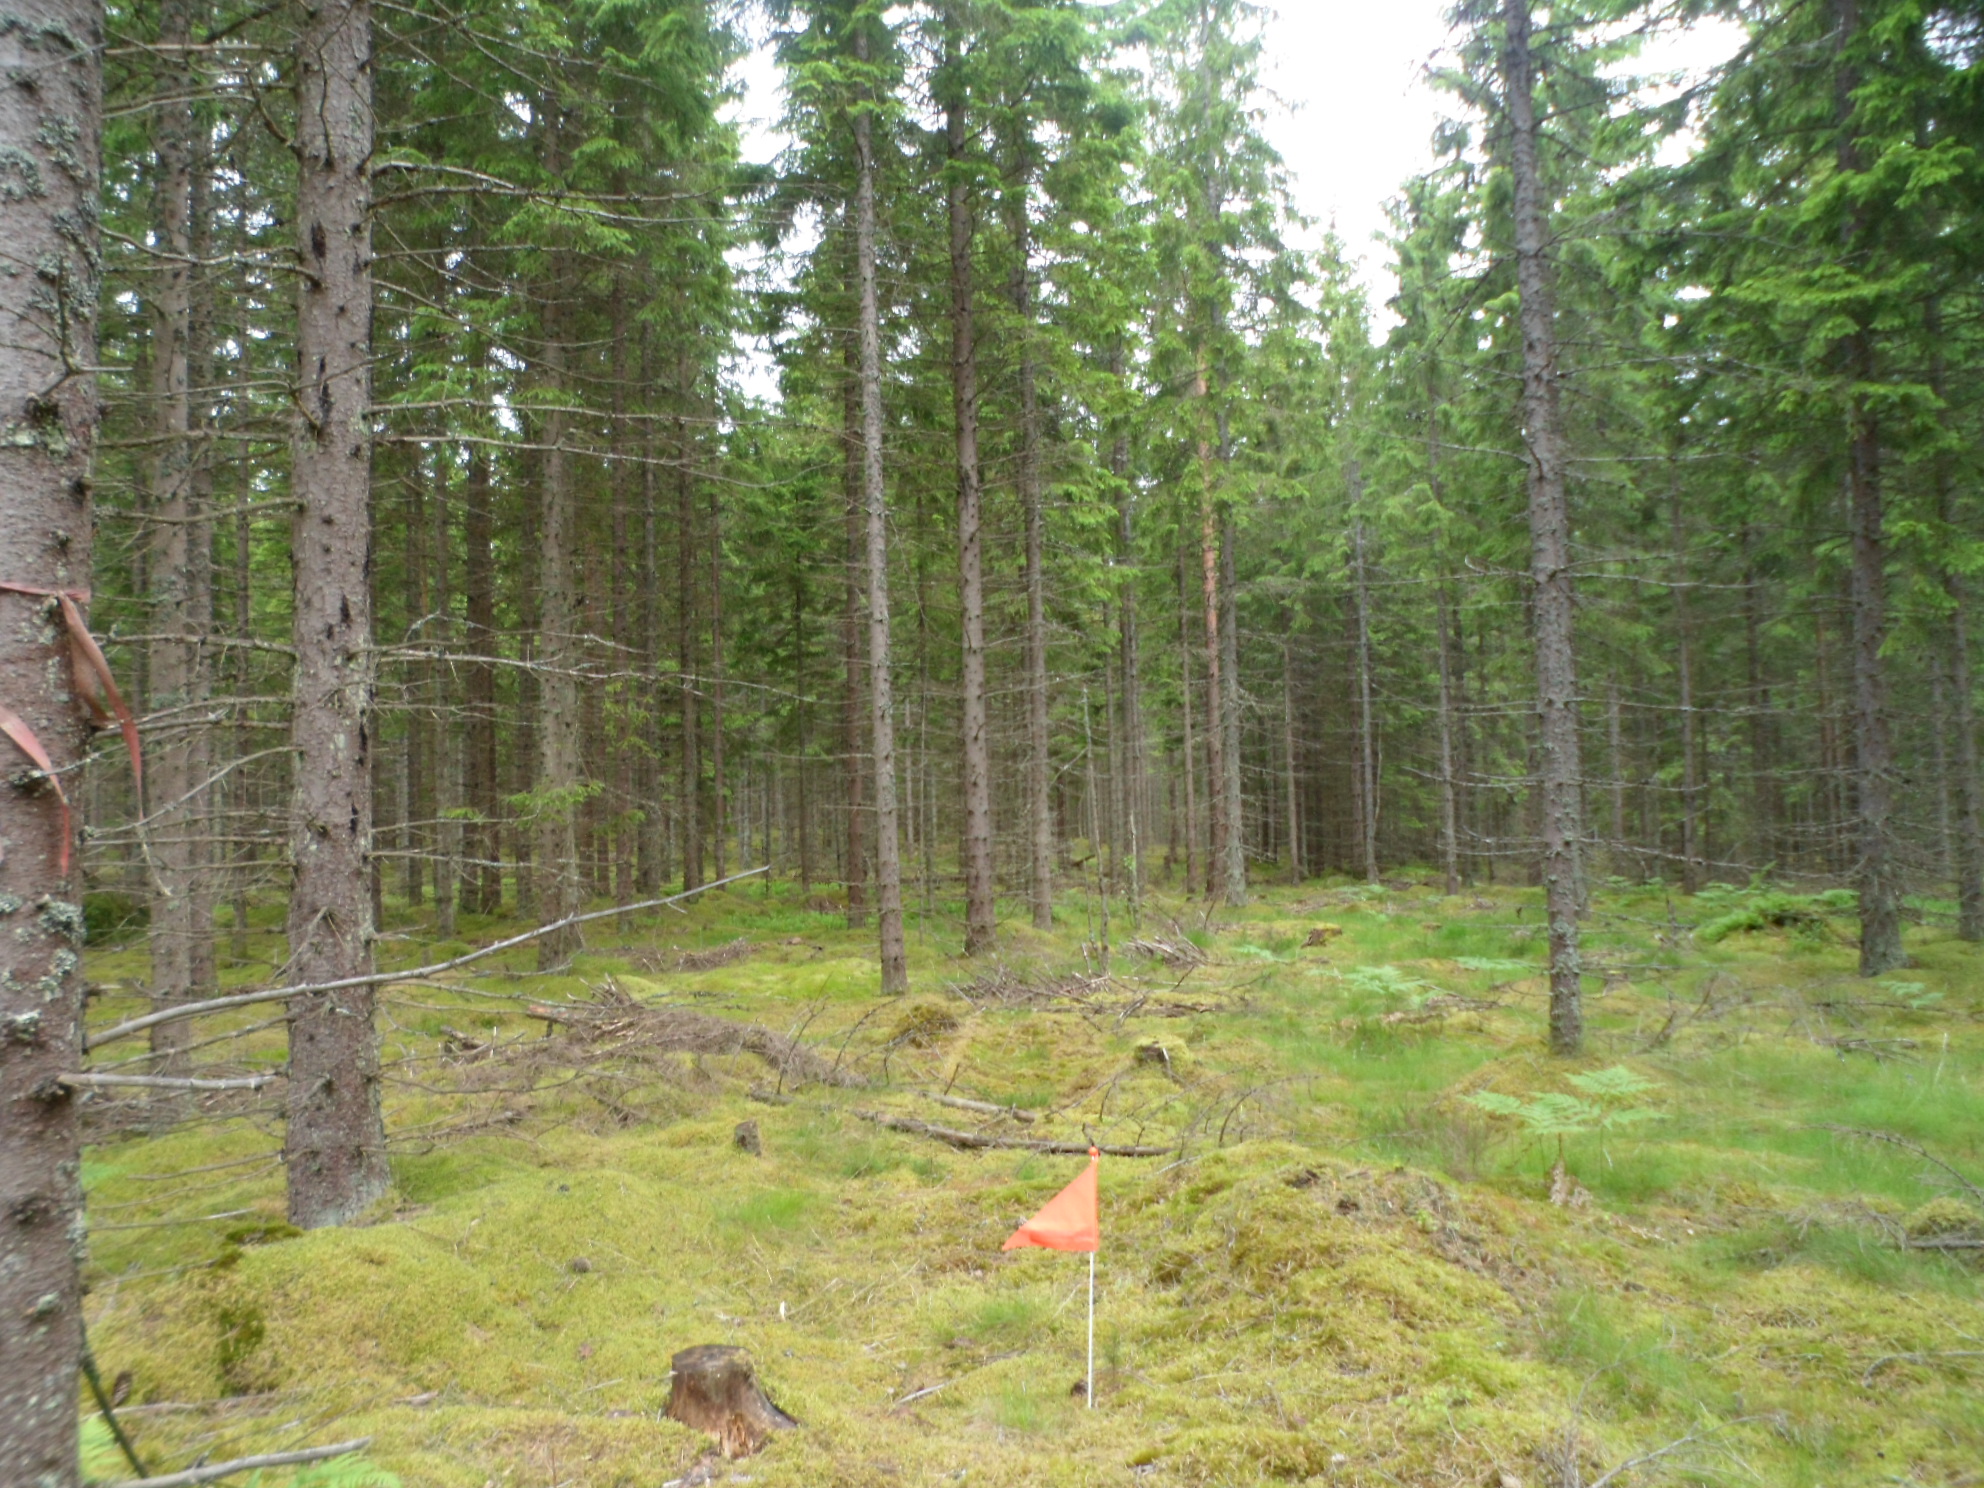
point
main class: Woodland
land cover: Spruce dominated coniferous woodland
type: boreal forest
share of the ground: 50 - 75 %
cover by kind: coniferous forest trees 55 %, lichens and mosses 30 %, shrubs 10 %, herbaceous plants 5 %
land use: Forestry
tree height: > 5 m
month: June
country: SE
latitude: 57.0546
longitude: 15.2237
